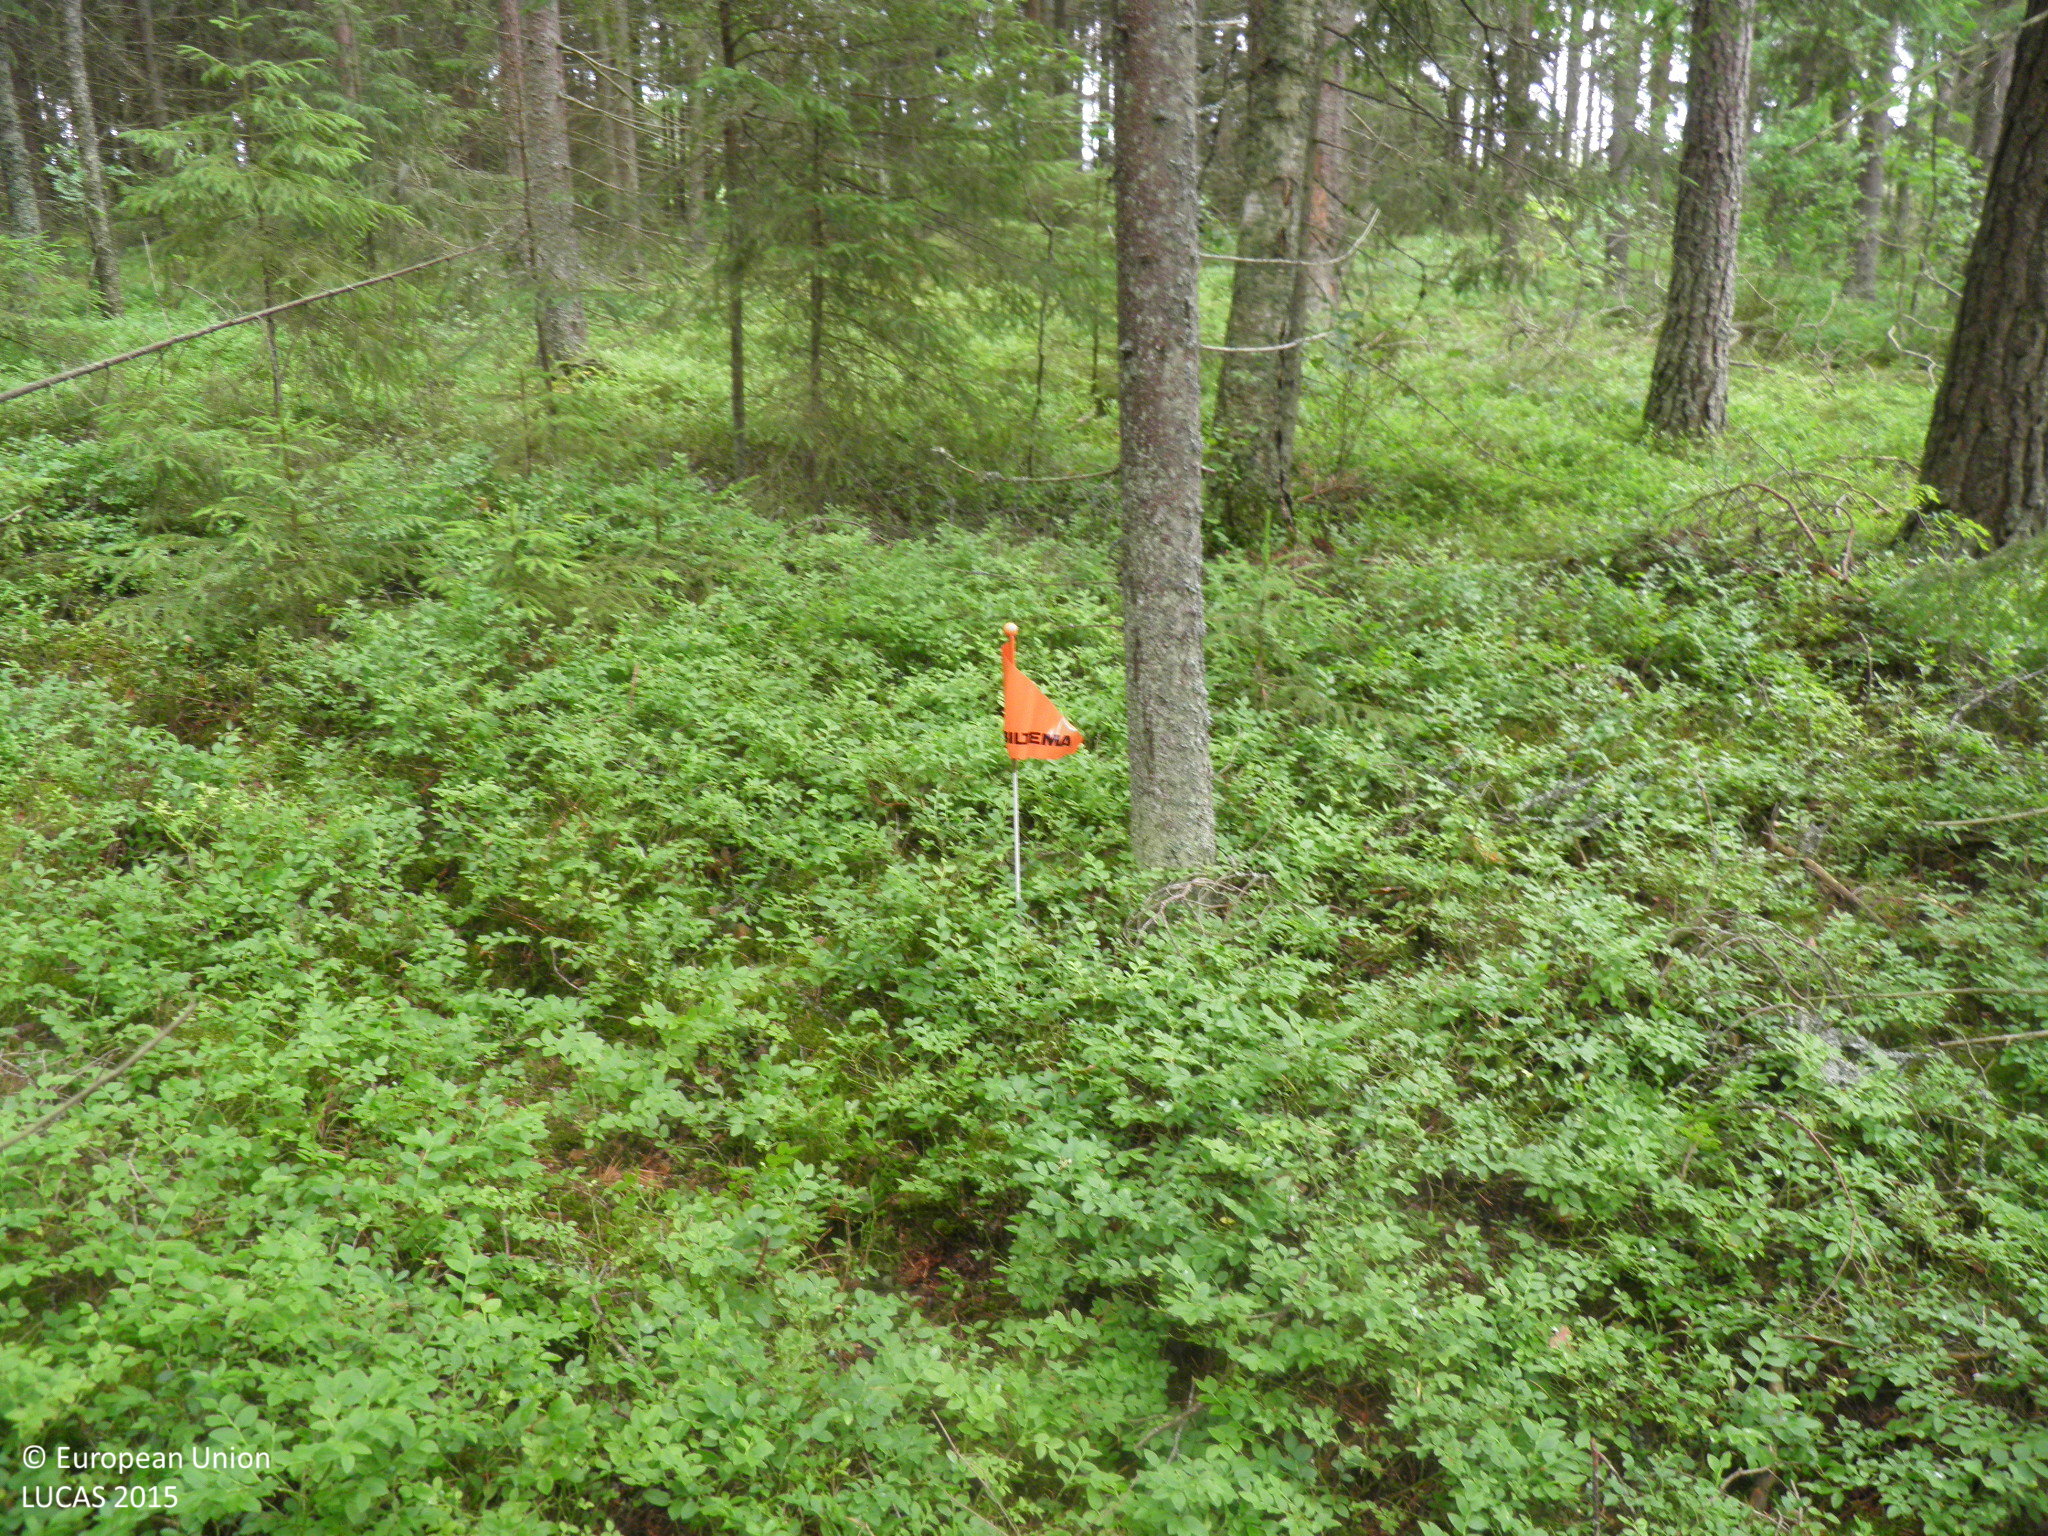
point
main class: Woodland
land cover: Spruce dominated coniferous woodland
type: boreal forest
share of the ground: > 75 %
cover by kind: coniferous forest trees 60 %, broadleaved forest trees 15 %, shrubs 15 %, lichens and mosses 10 %
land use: Forestry
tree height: > 5 m
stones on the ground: < 10 %
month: July
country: FI
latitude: 60.7054
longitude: 22.8442
